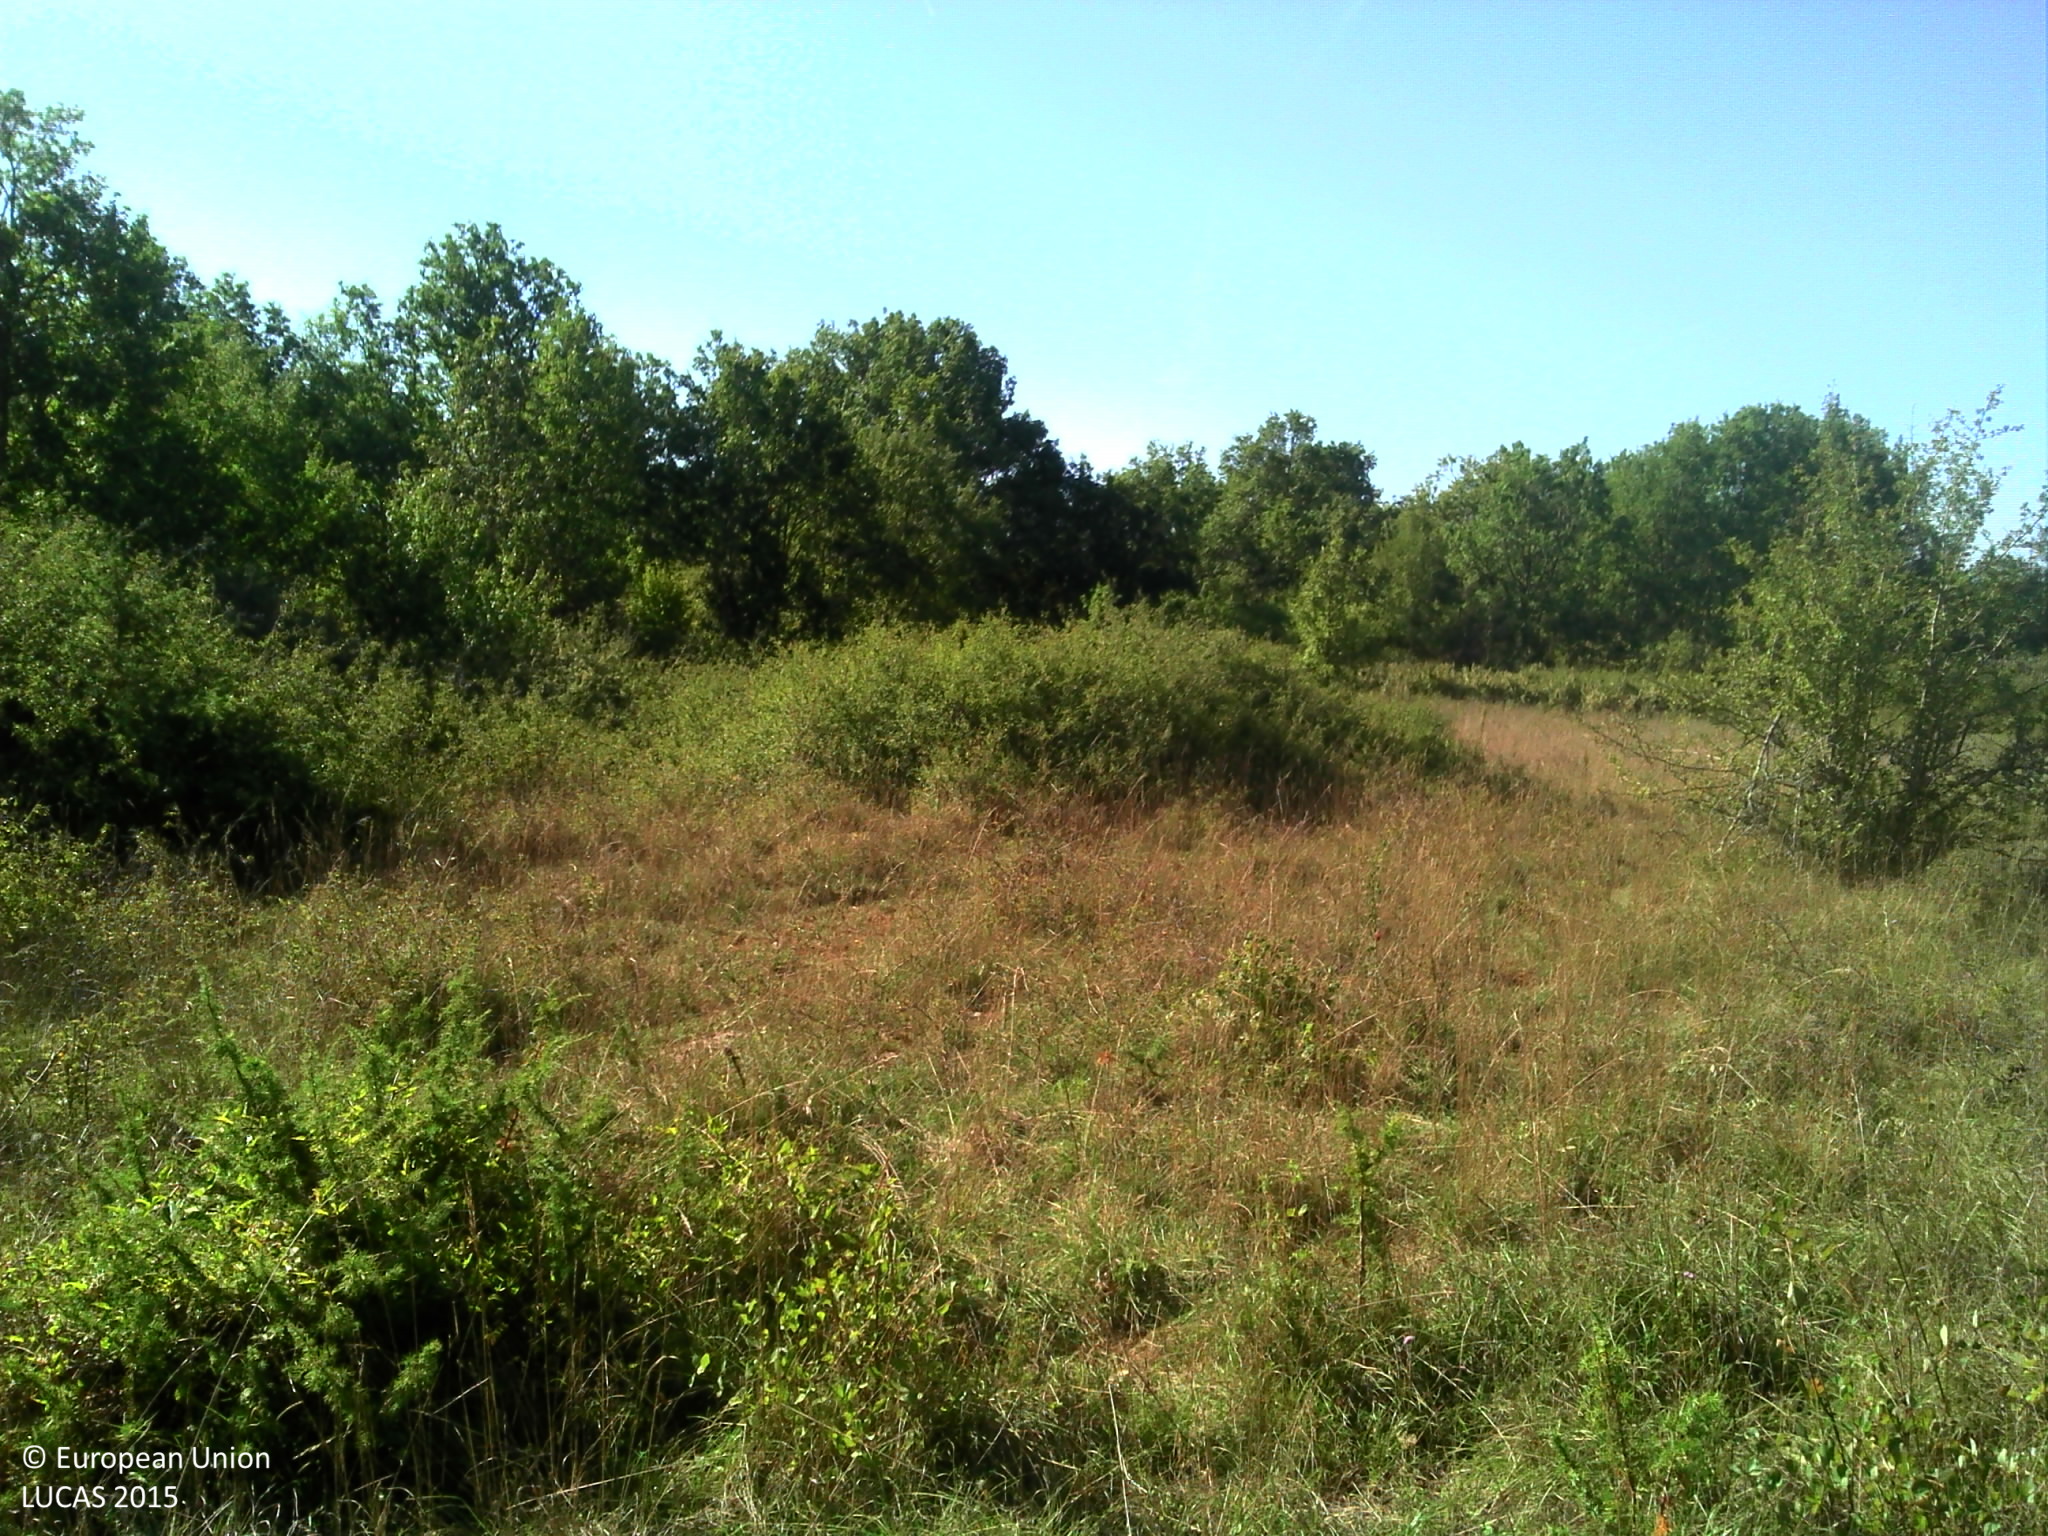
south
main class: Grassland
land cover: Grassland with sparse tree/shrub cover
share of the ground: > 75 %
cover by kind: herbaceous plants 85 %, shrubs 10 %, broadleaved forest trees 5 %
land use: Agriculture (excluding fallow land and kitchen gardens)
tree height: > 5 m
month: August
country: FR
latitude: 44.3564
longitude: 1.6312
